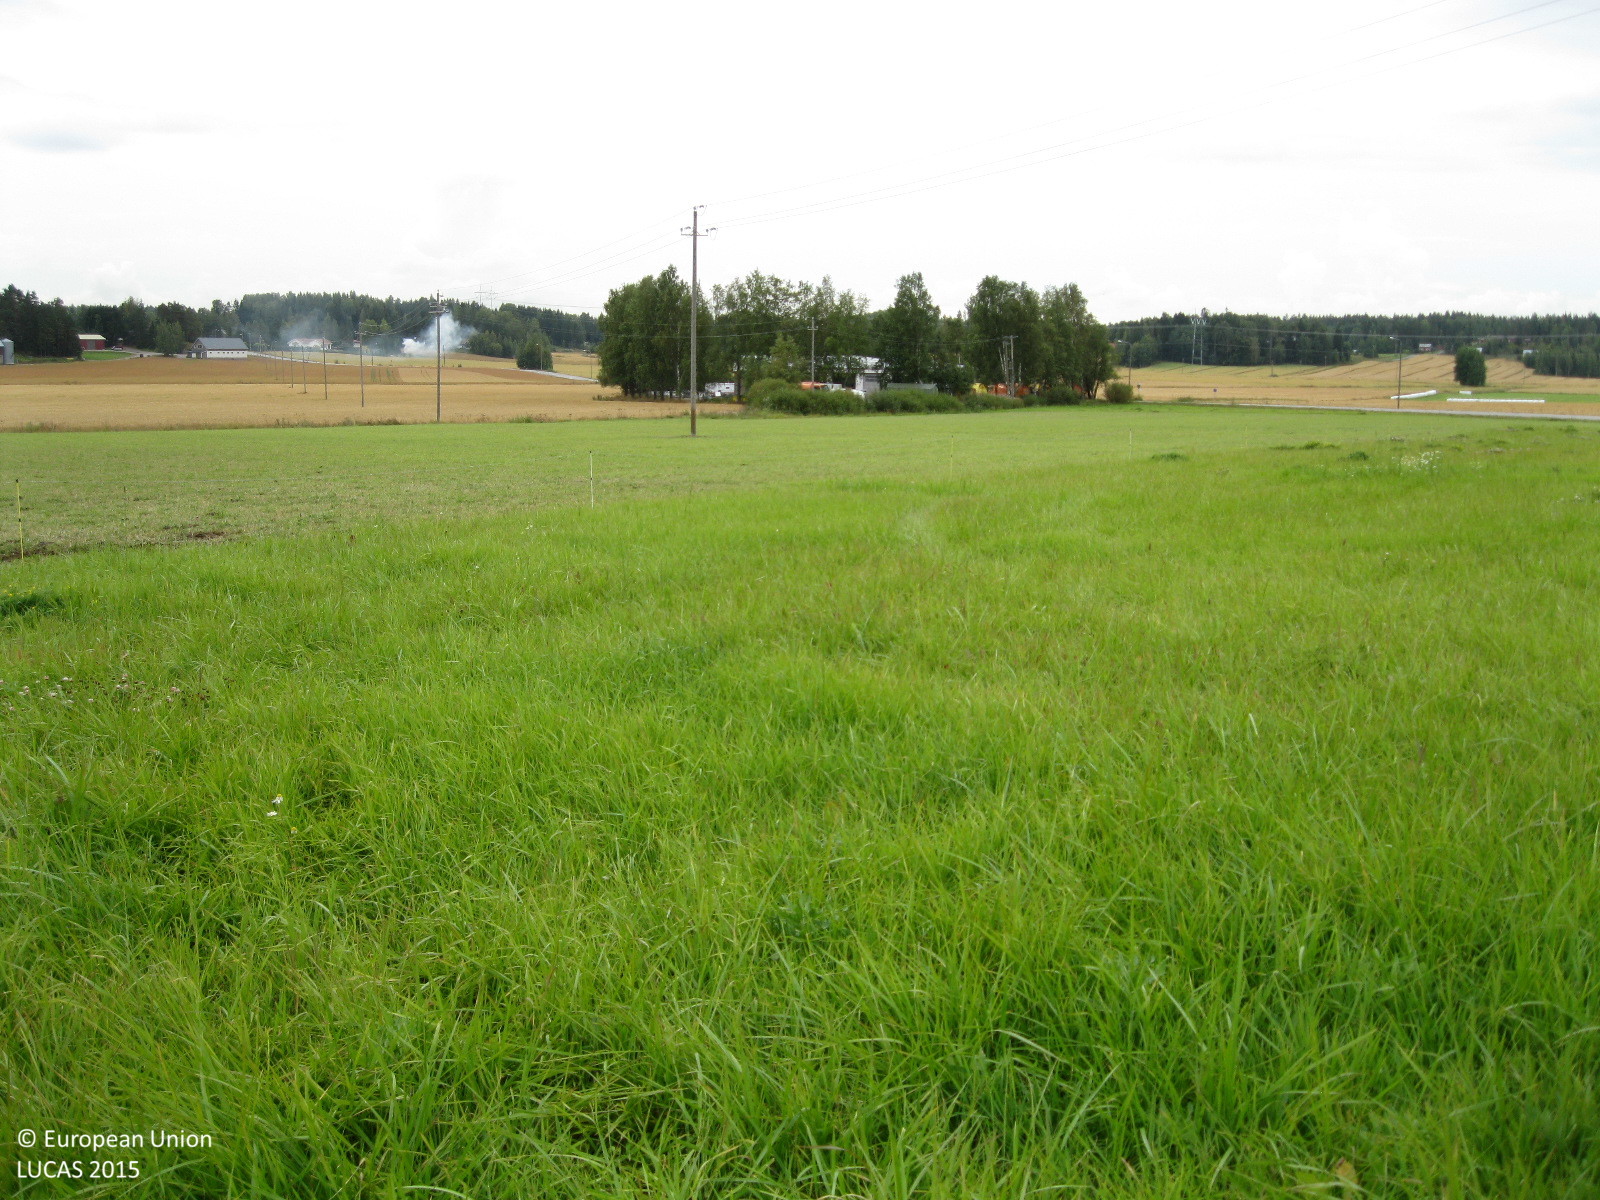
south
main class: Cropland
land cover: Temporary grasslands
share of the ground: > 75 %
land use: Agriculture (excluding fallow land and kitchen gardens)
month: September
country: FI
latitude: 60.4040
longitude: 24.7984
